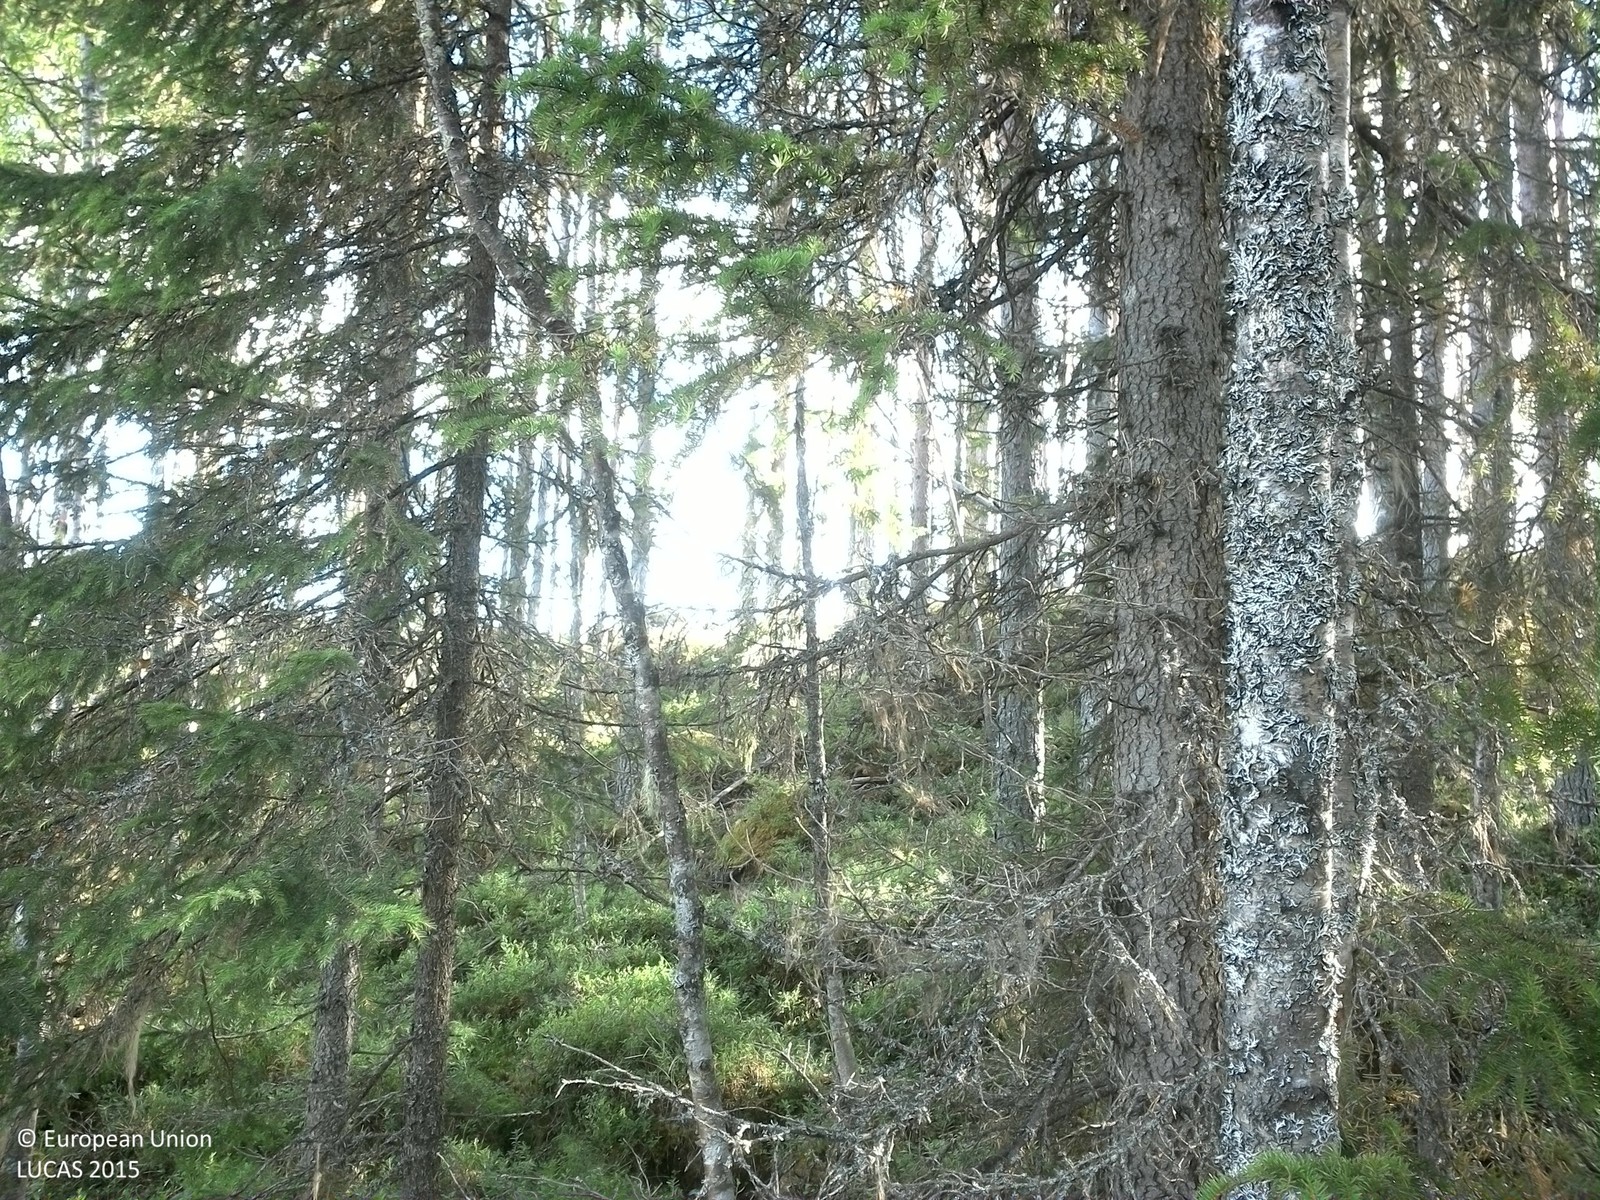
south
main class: Woodland
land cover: Pine dominated mixed woodland
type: boreal forest
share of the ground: > 75 %
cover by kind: coniferous forest trees 50 %, broadleaved forest trees 25 %, shrubs 15 %, lichens and mosses 10 %
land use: Forestry
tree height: > 5 m
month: August
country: SE
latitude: 64.0891
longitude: 17.2104
